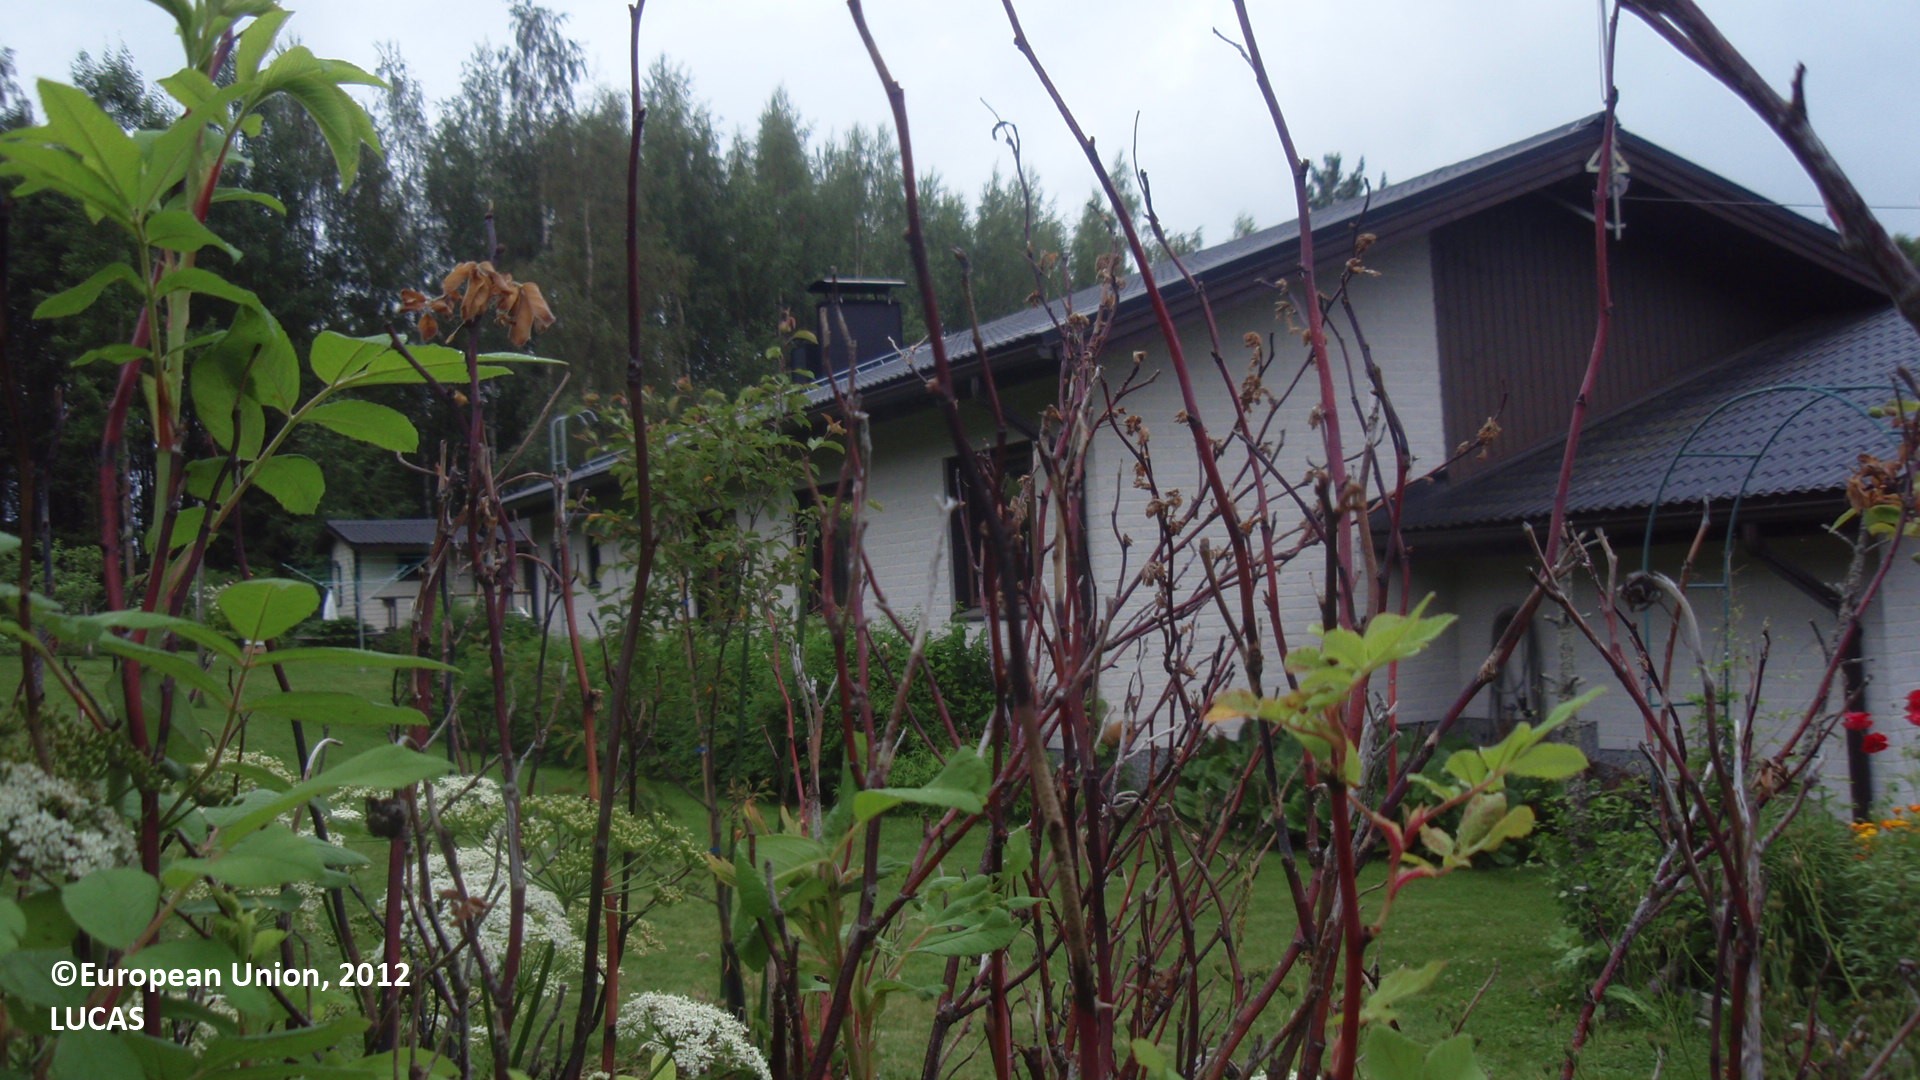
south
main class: Grassland
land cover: Grassland with sparse tree/shrub cover
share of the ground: > 75 %
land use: Residential
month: July
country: FI
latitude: 61.1552
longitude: 28.7504
